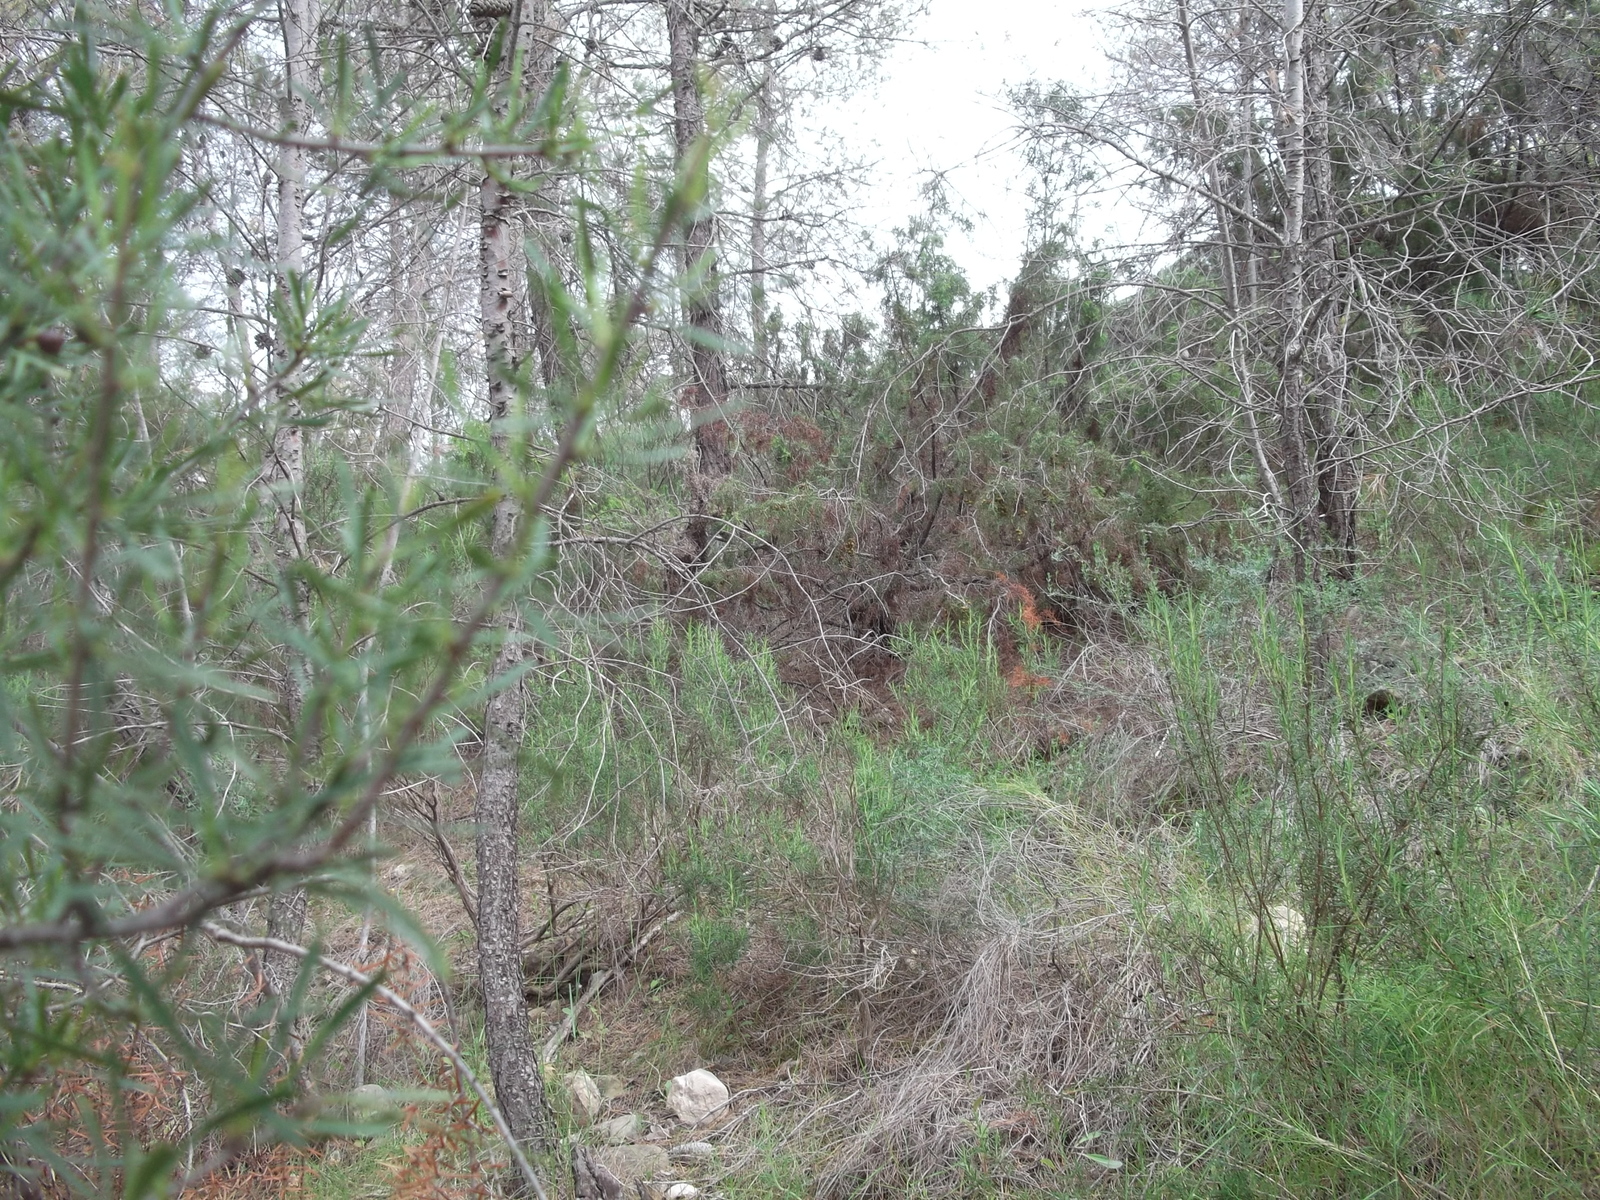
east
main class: Woodland
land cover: Pine dominated coniferous woodland
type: coniferous forest of the mediterranean region
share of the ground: 25 - 50 %
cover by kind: shrubs 60 %, coniferous forest trees 40 %
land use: Forestry
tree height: > 5 m
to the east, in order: Pine dominated coniferous woodland; Tracks; Pine dominated coniferous woodland; Tracks; Pine dominated coniferous woodland; Tracks; Nuts trees; Tracks; Pine dominated coniferous woodland
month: April
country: ES
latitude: 37.9370
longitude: -1.5570
